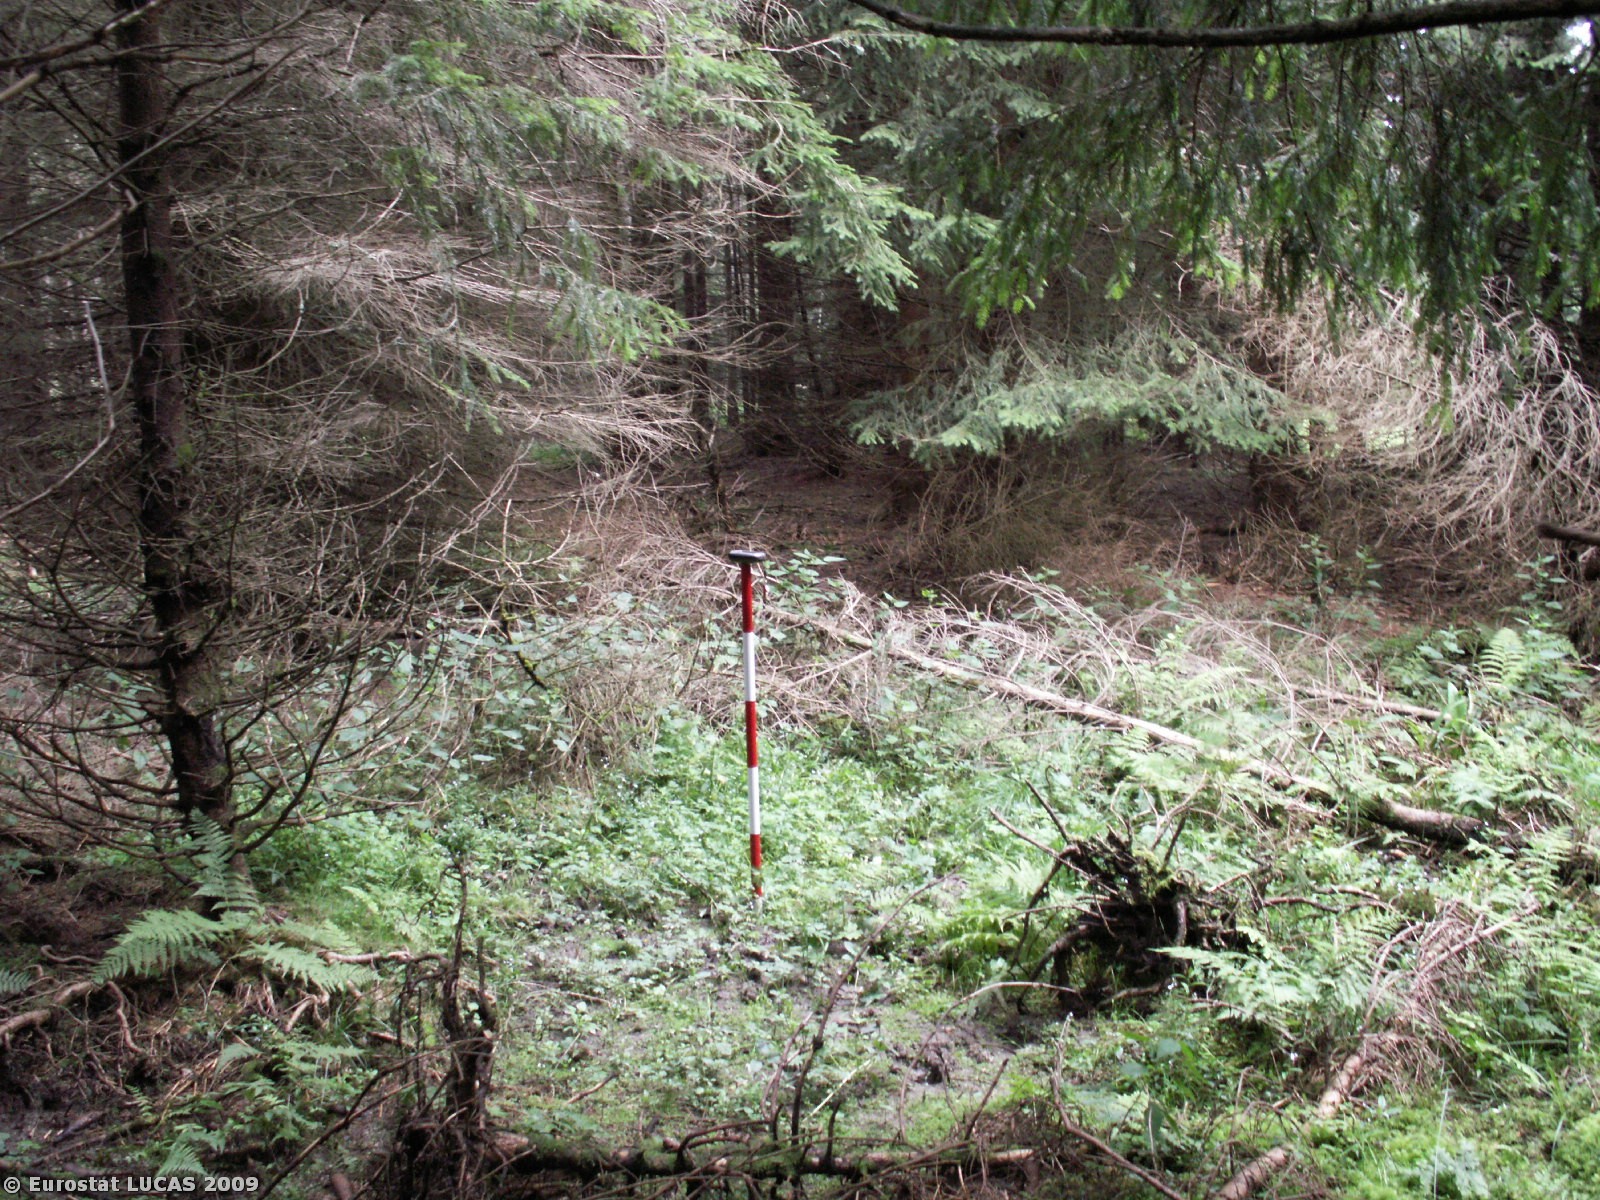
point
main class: Woodland
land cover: Coniferous woodland
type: hemiboreal forest and nemoral coniferous forest and mixed broadleaved-coniferous forest
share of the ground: > 75 %
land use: Forestry
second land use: Nature reserves
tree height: > 5 m
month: July
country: CZ
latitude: 50.0797
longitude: 12.7248
